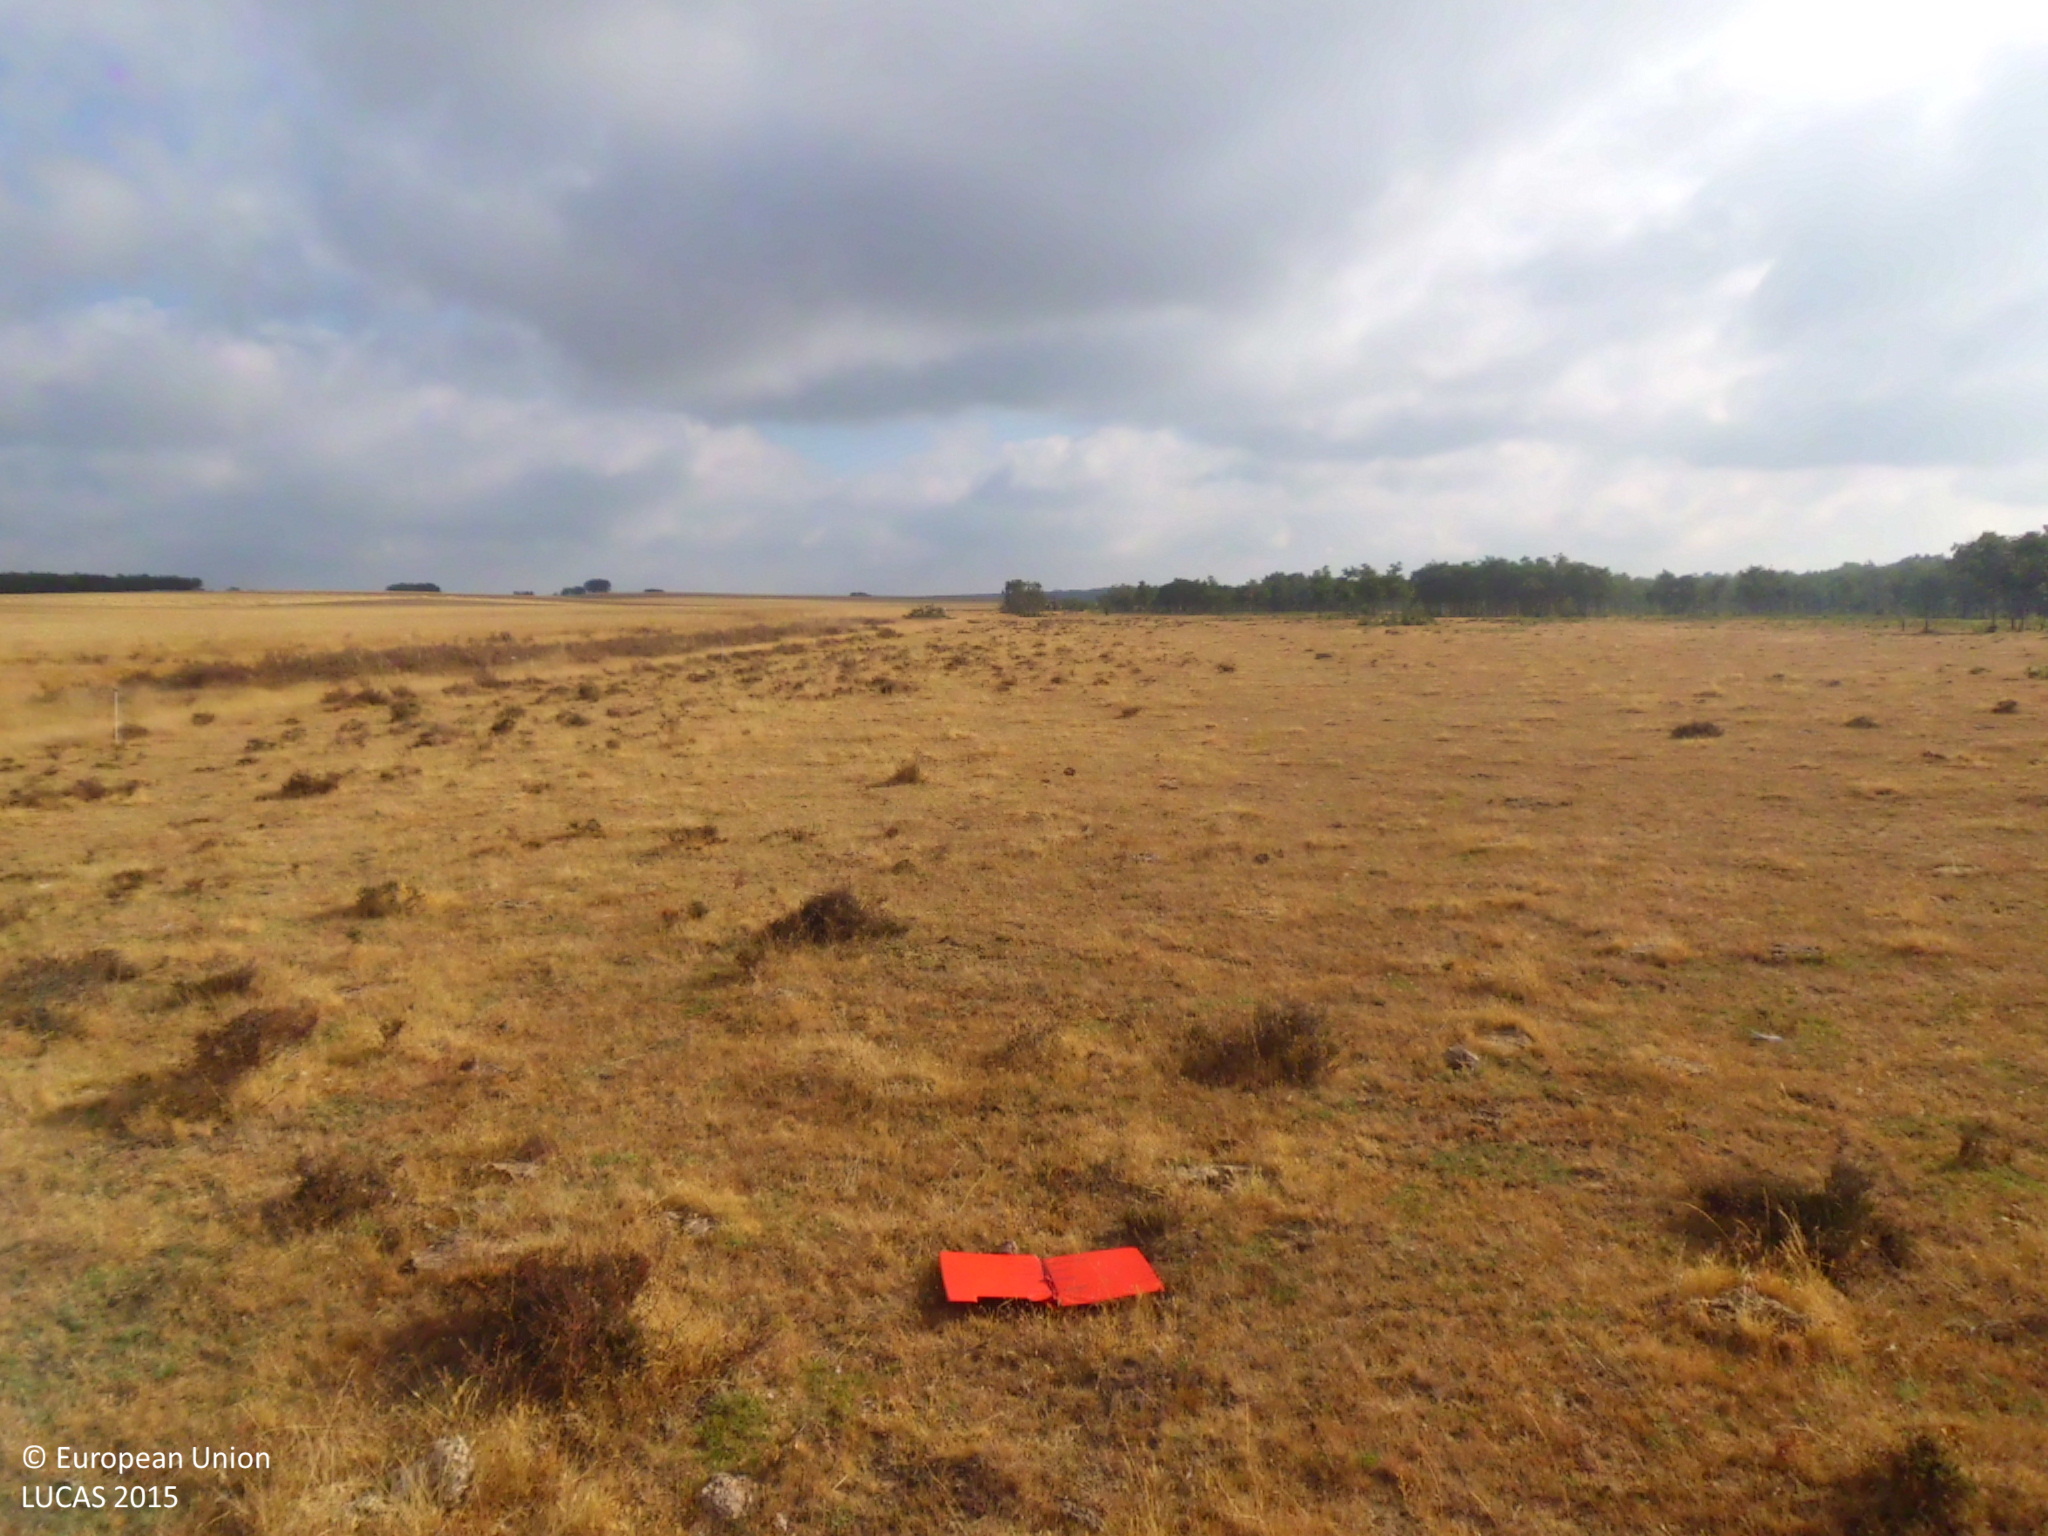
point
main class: Grassland
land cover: Grassland without tree/shrub cover
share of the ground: > 75 %
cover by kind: herbaceous plants 90 %, unconsolidated bare surface 10 %
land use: Agriculture (excluding fallow land and kitchen gardens)
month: July
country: ES
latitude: 42.5700
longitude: -4.9093
